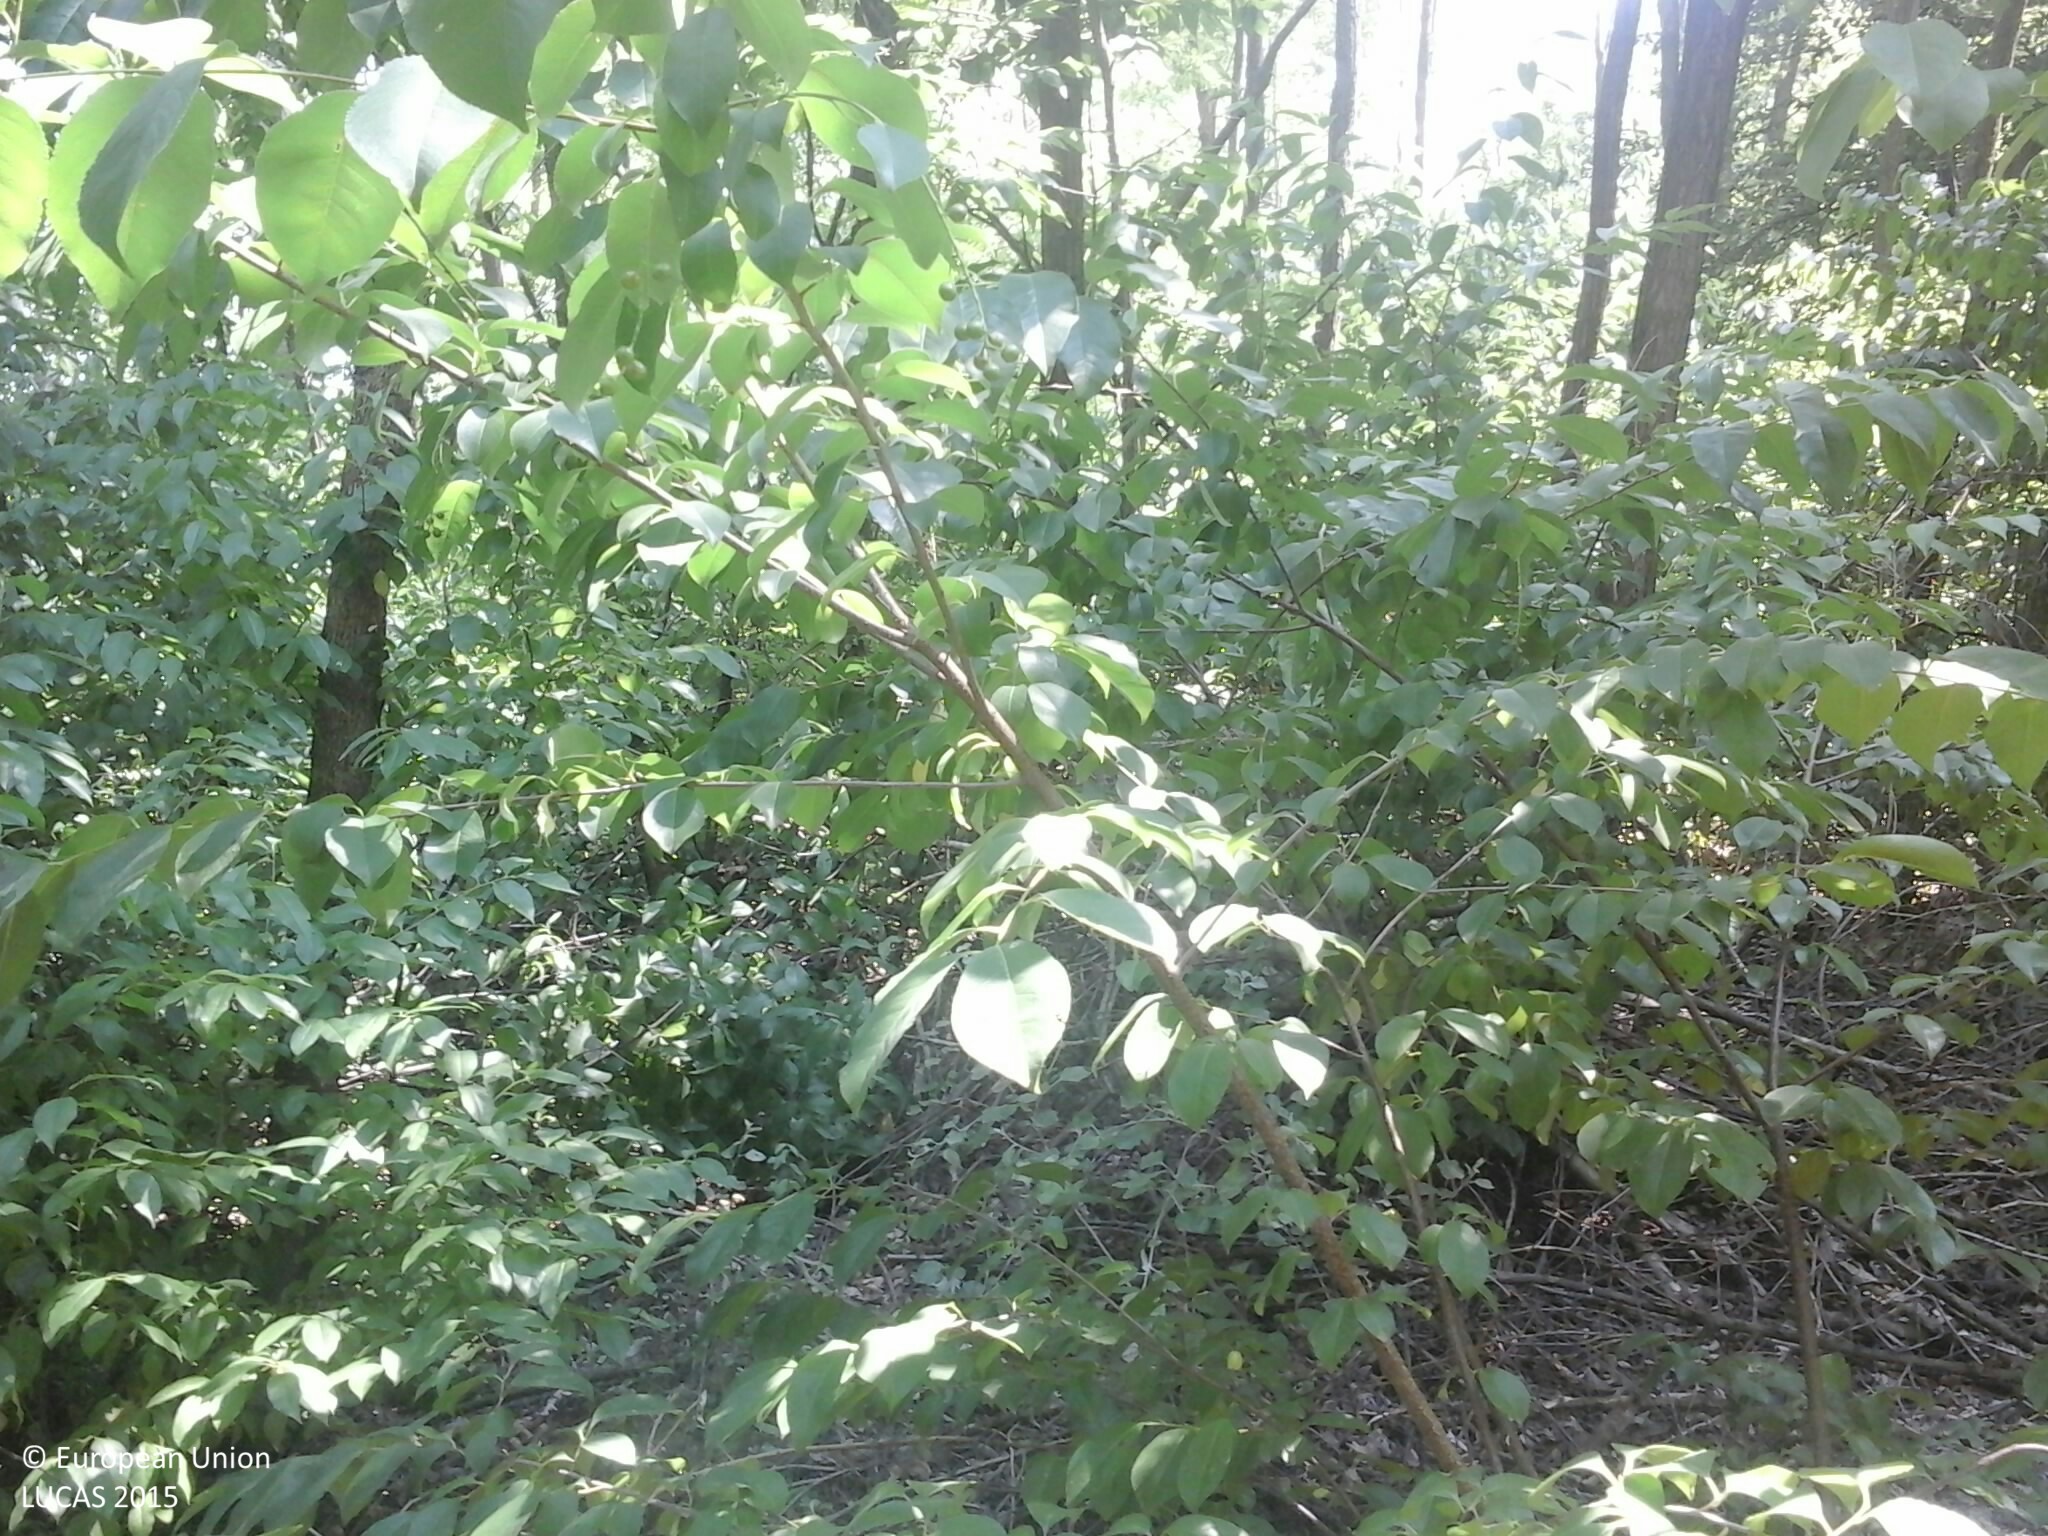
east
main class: Woodland
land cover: Broadleaved woodland
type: mesophytic deciduous forest
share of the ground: > 75 %
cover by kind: broadleaved forest trees 95 %, herbaceous plants 5 %
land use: Forestry
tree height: > 5 m
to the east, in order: Broadleaved woodland; Triticale; Common wheat; Tracks; Broadleaved woodland
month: July
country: HU
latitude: 47.6689
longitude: 22.0505
